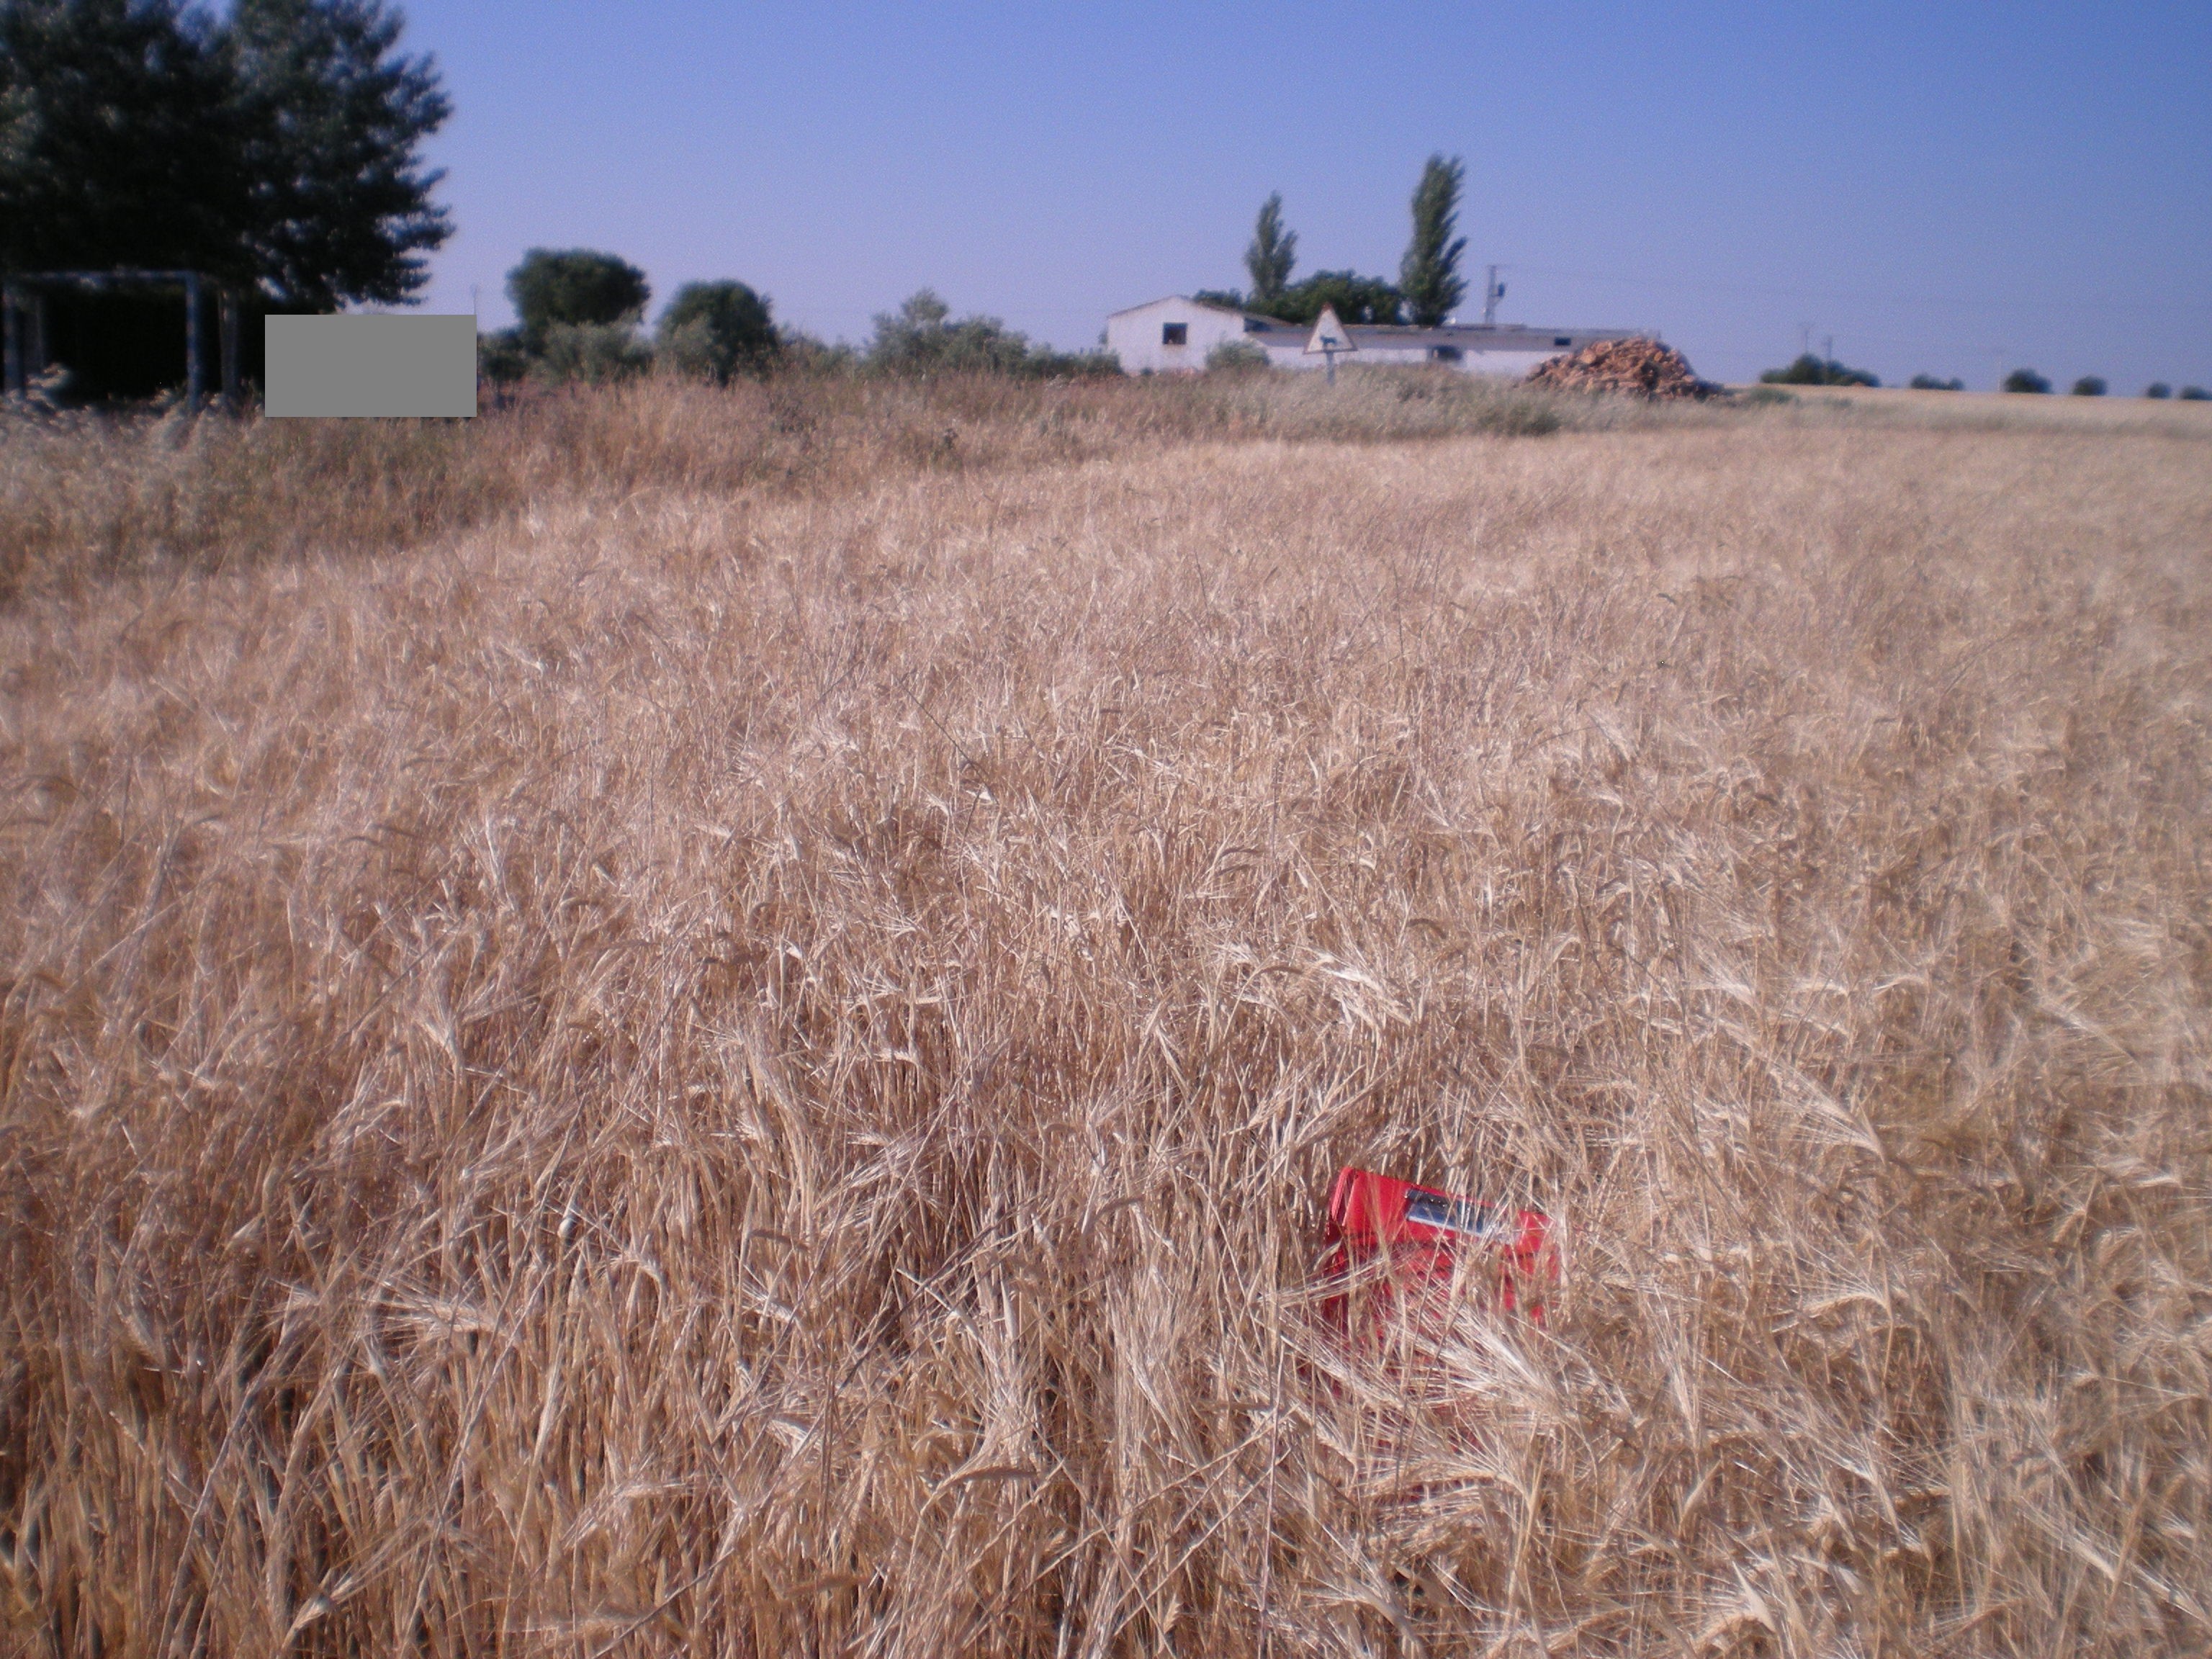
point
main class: Cropland
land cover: Barley
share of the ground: > 75 %
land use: Agriculture (excluding fallow land and kitchen gardens)
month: May
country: ES
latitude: 39.0384
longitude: -3.6153
